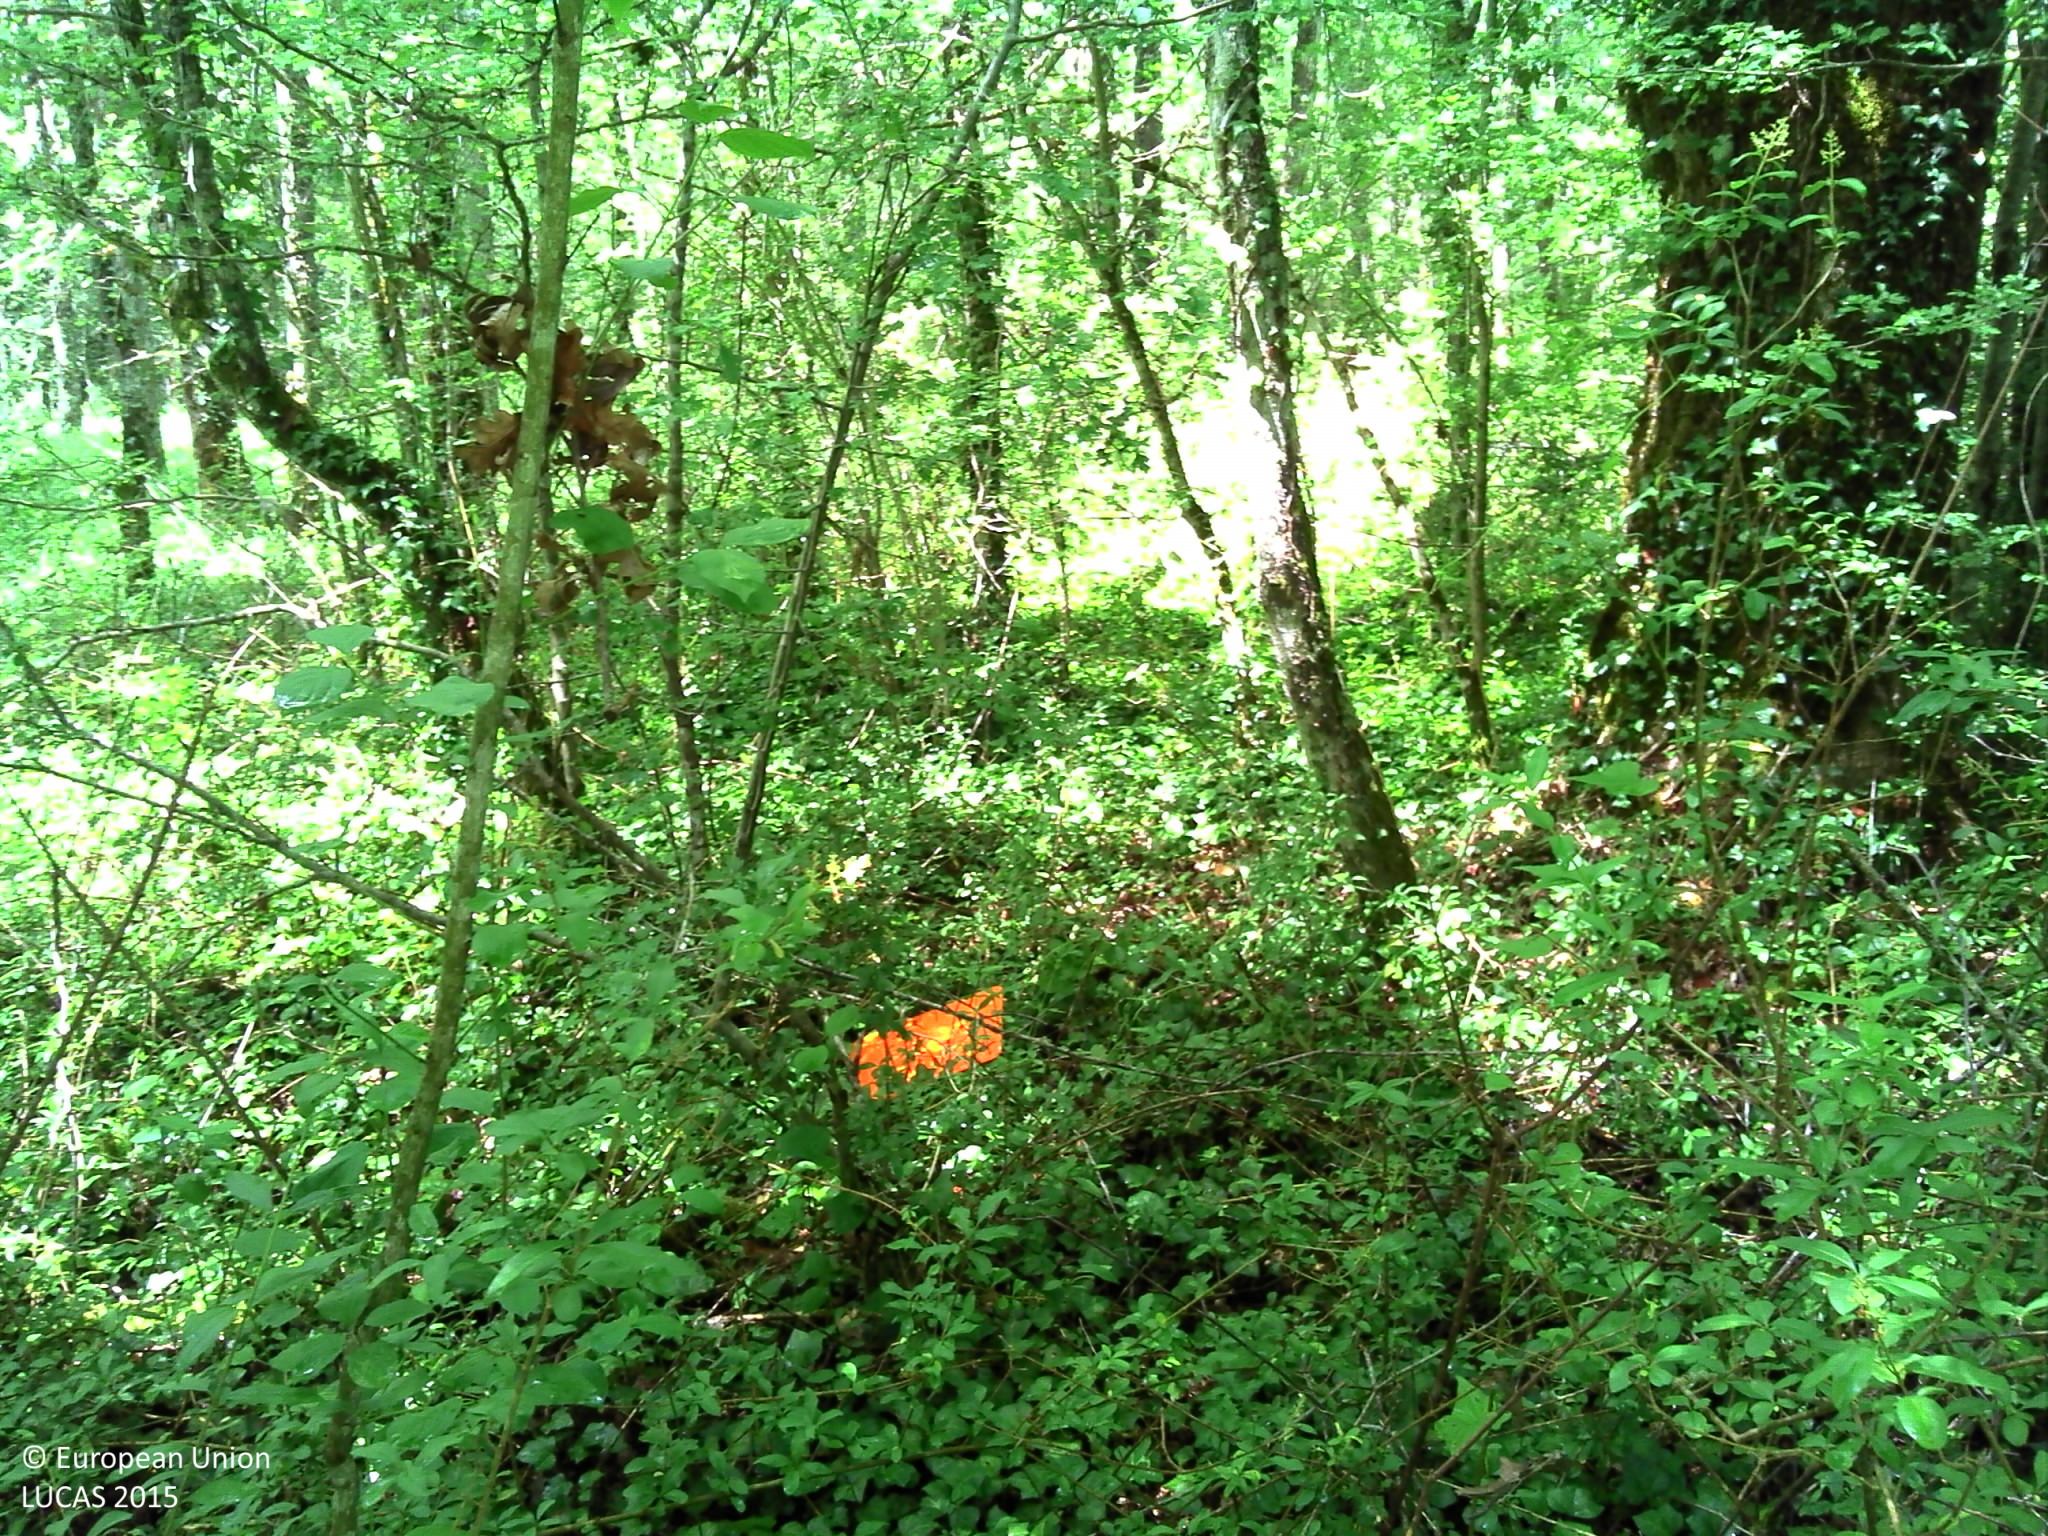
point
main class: Woodland
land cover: Broadleaved woodland
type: acidophilous oak and oak-birch forest
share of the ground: > 75 %
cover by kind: broadleaved forest trees 75 %, herbaceous plants 15 %, shrubs 5 %, lichens and mosses 5 %
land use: Forestry
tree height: > 5 m
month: June
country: FR
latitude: 44.2867
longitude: 1.8933
